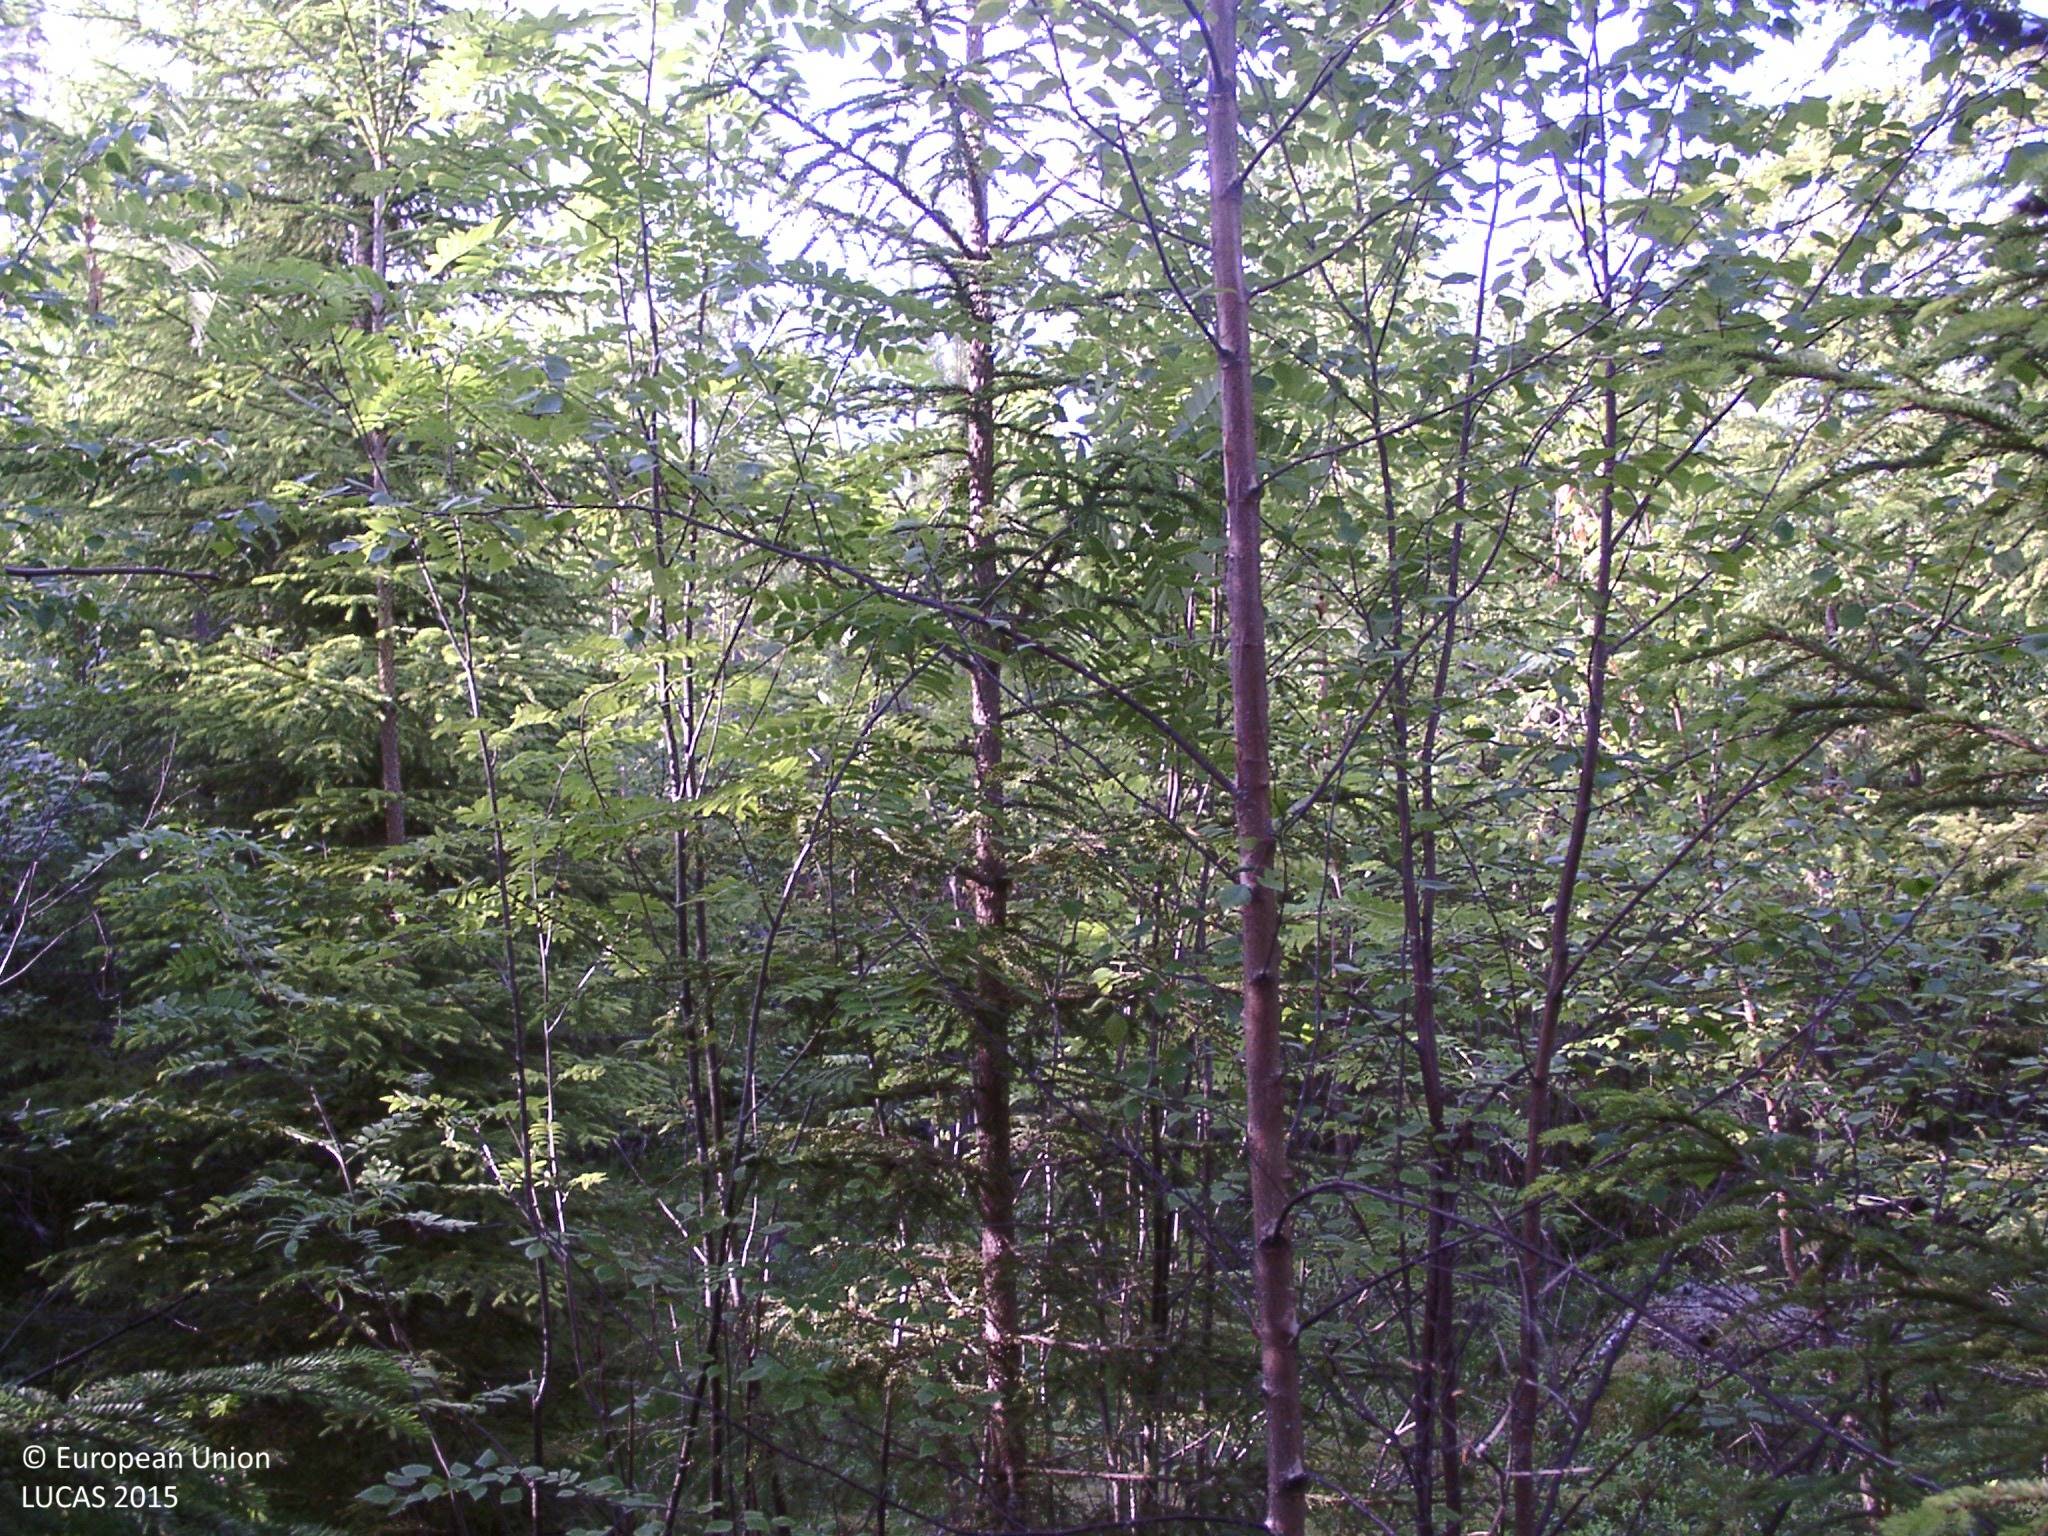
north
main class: Woodland
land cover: Spruce dominated mixed woodland
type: boreal forest
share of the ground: > 75 %
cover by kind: broadleaved forest trees 45 %, coniferous forest trees 40 %, shrubs 5 %, herbaceous plants 5 %, lichens and mosses 5 %
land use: Forestry
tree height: < 5 m
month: July
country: FI
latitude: 62.2456
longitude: 25.1392
